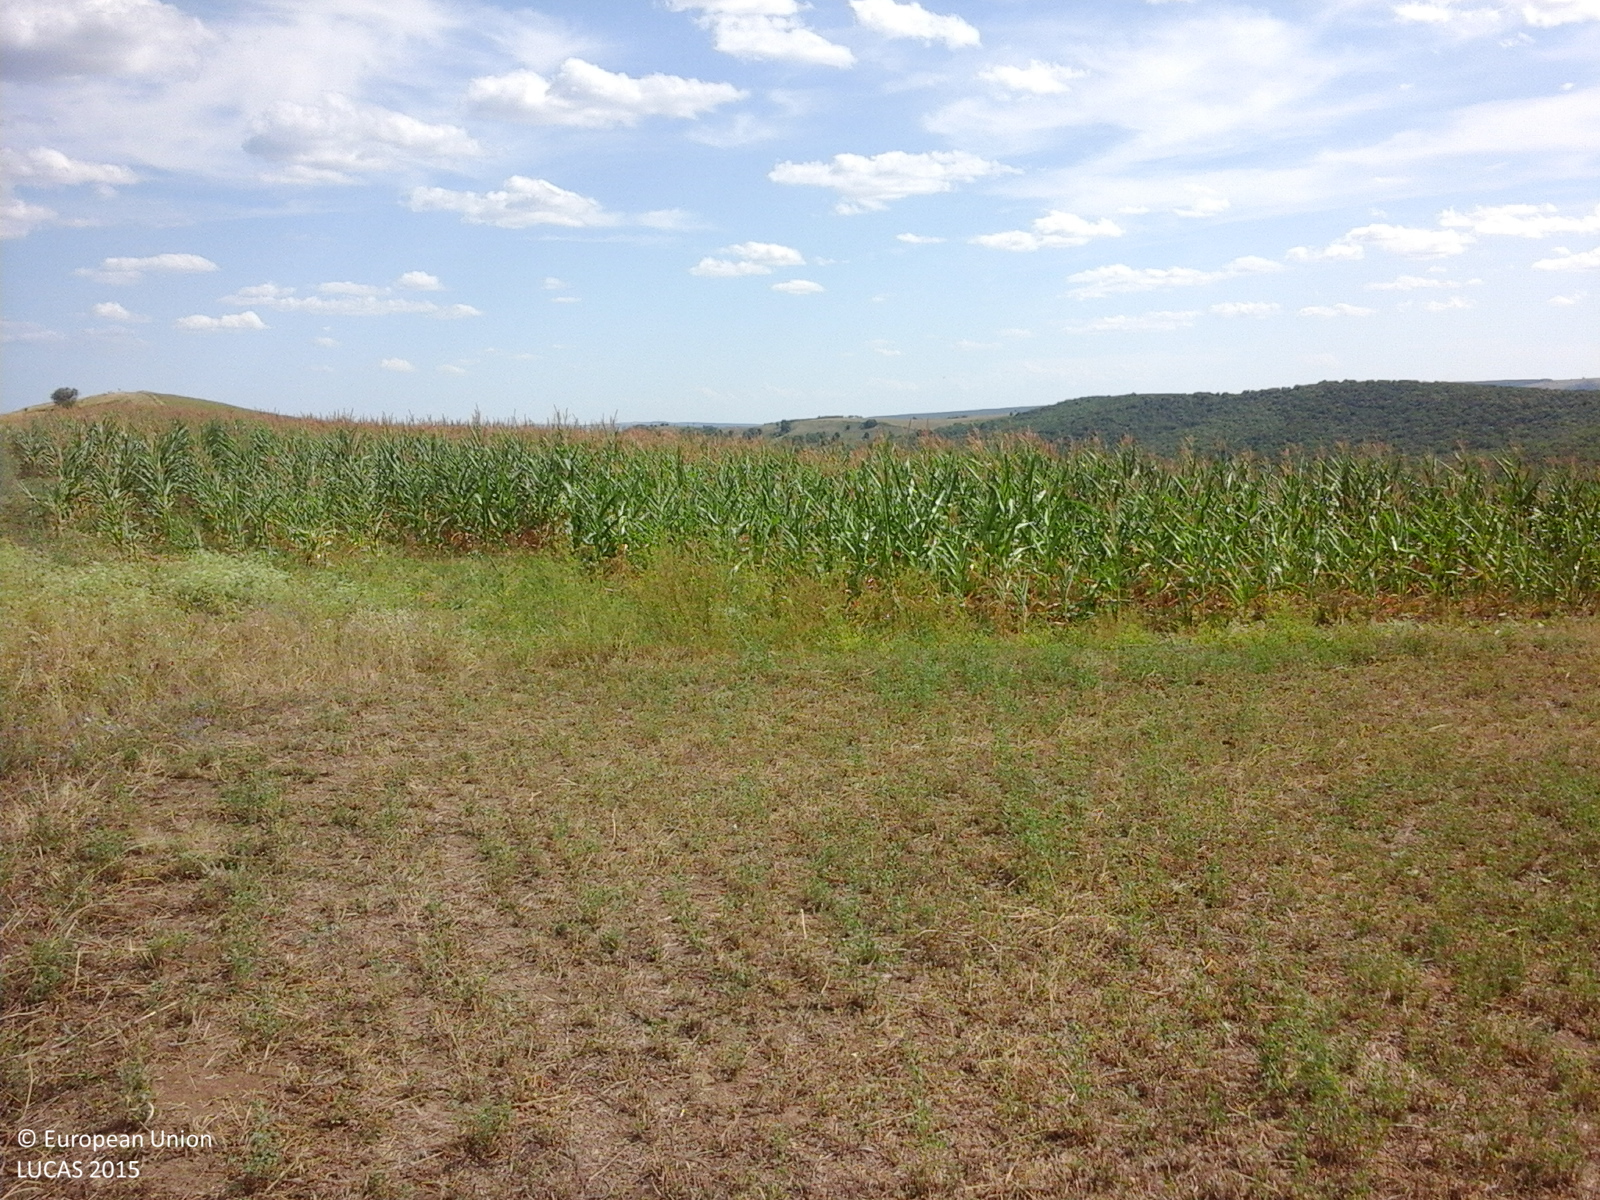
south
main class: Cropland
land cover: Lucerne
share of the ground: 25 - 50 %
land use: Agriculture (excluding fallow land and kitchen gardens)
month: July
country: RO
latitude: 46.3682
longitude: 27.3816
